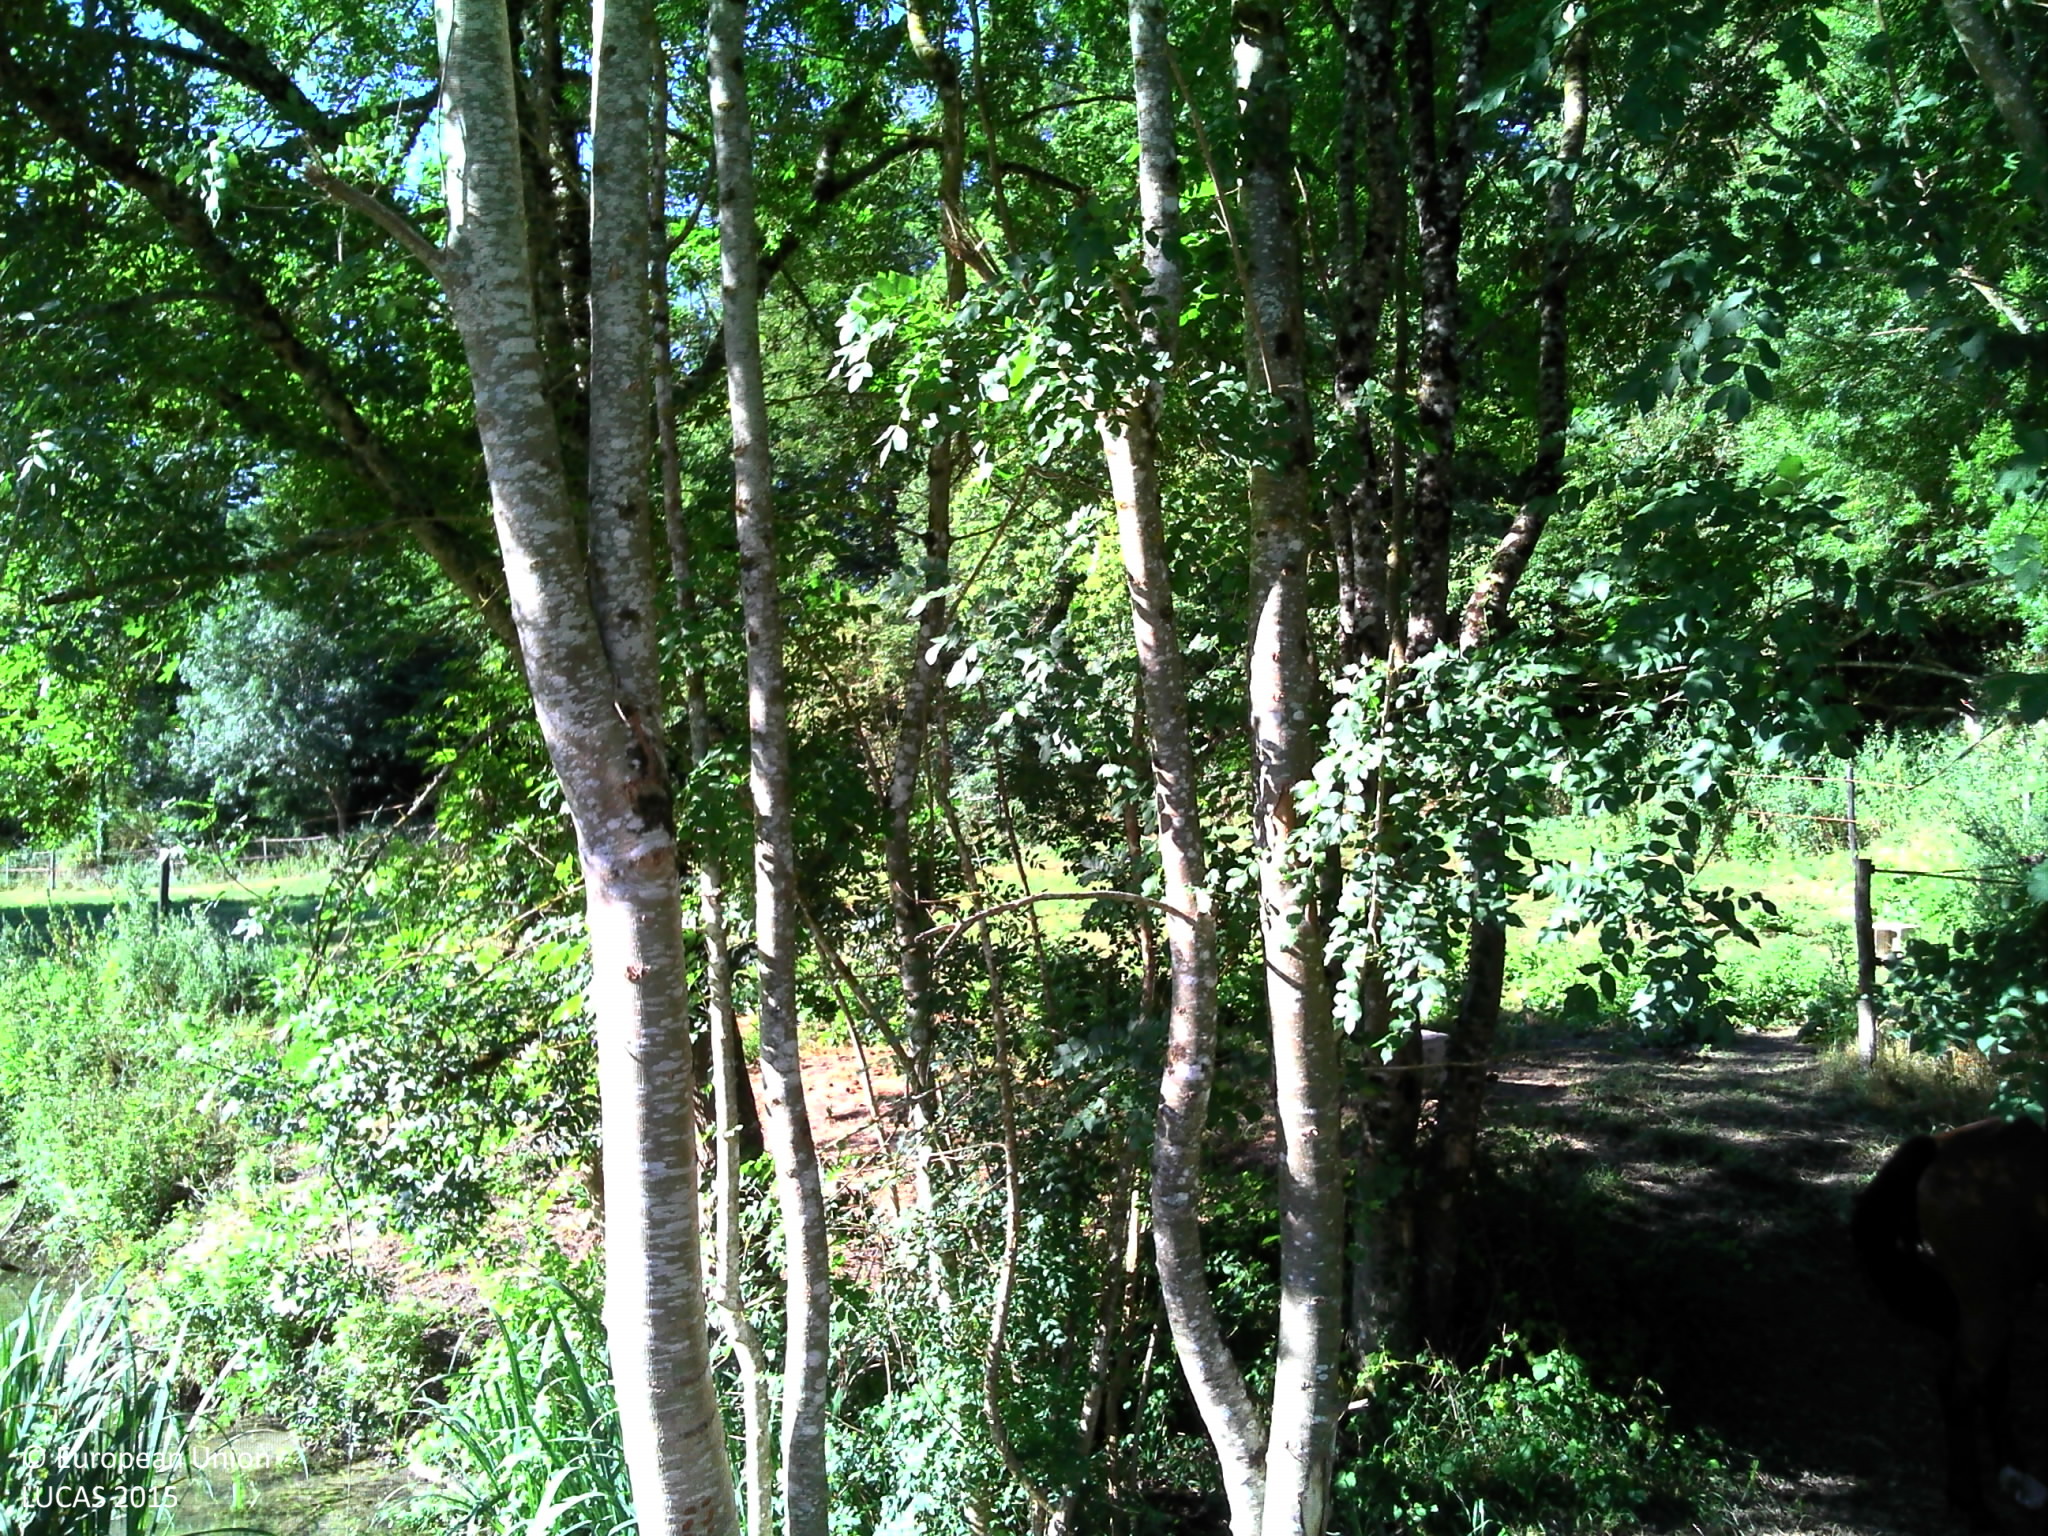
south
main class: Grassland
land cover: Grassland without tree/shrub cover
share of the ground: > 75 %
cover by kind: herbaceous plants 90 %, lichens and mosses 10 %
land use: Agriculture (excluding fallow land and kitchen gardens)
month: July
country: FR
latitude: 44.7559
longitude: 0.5803
